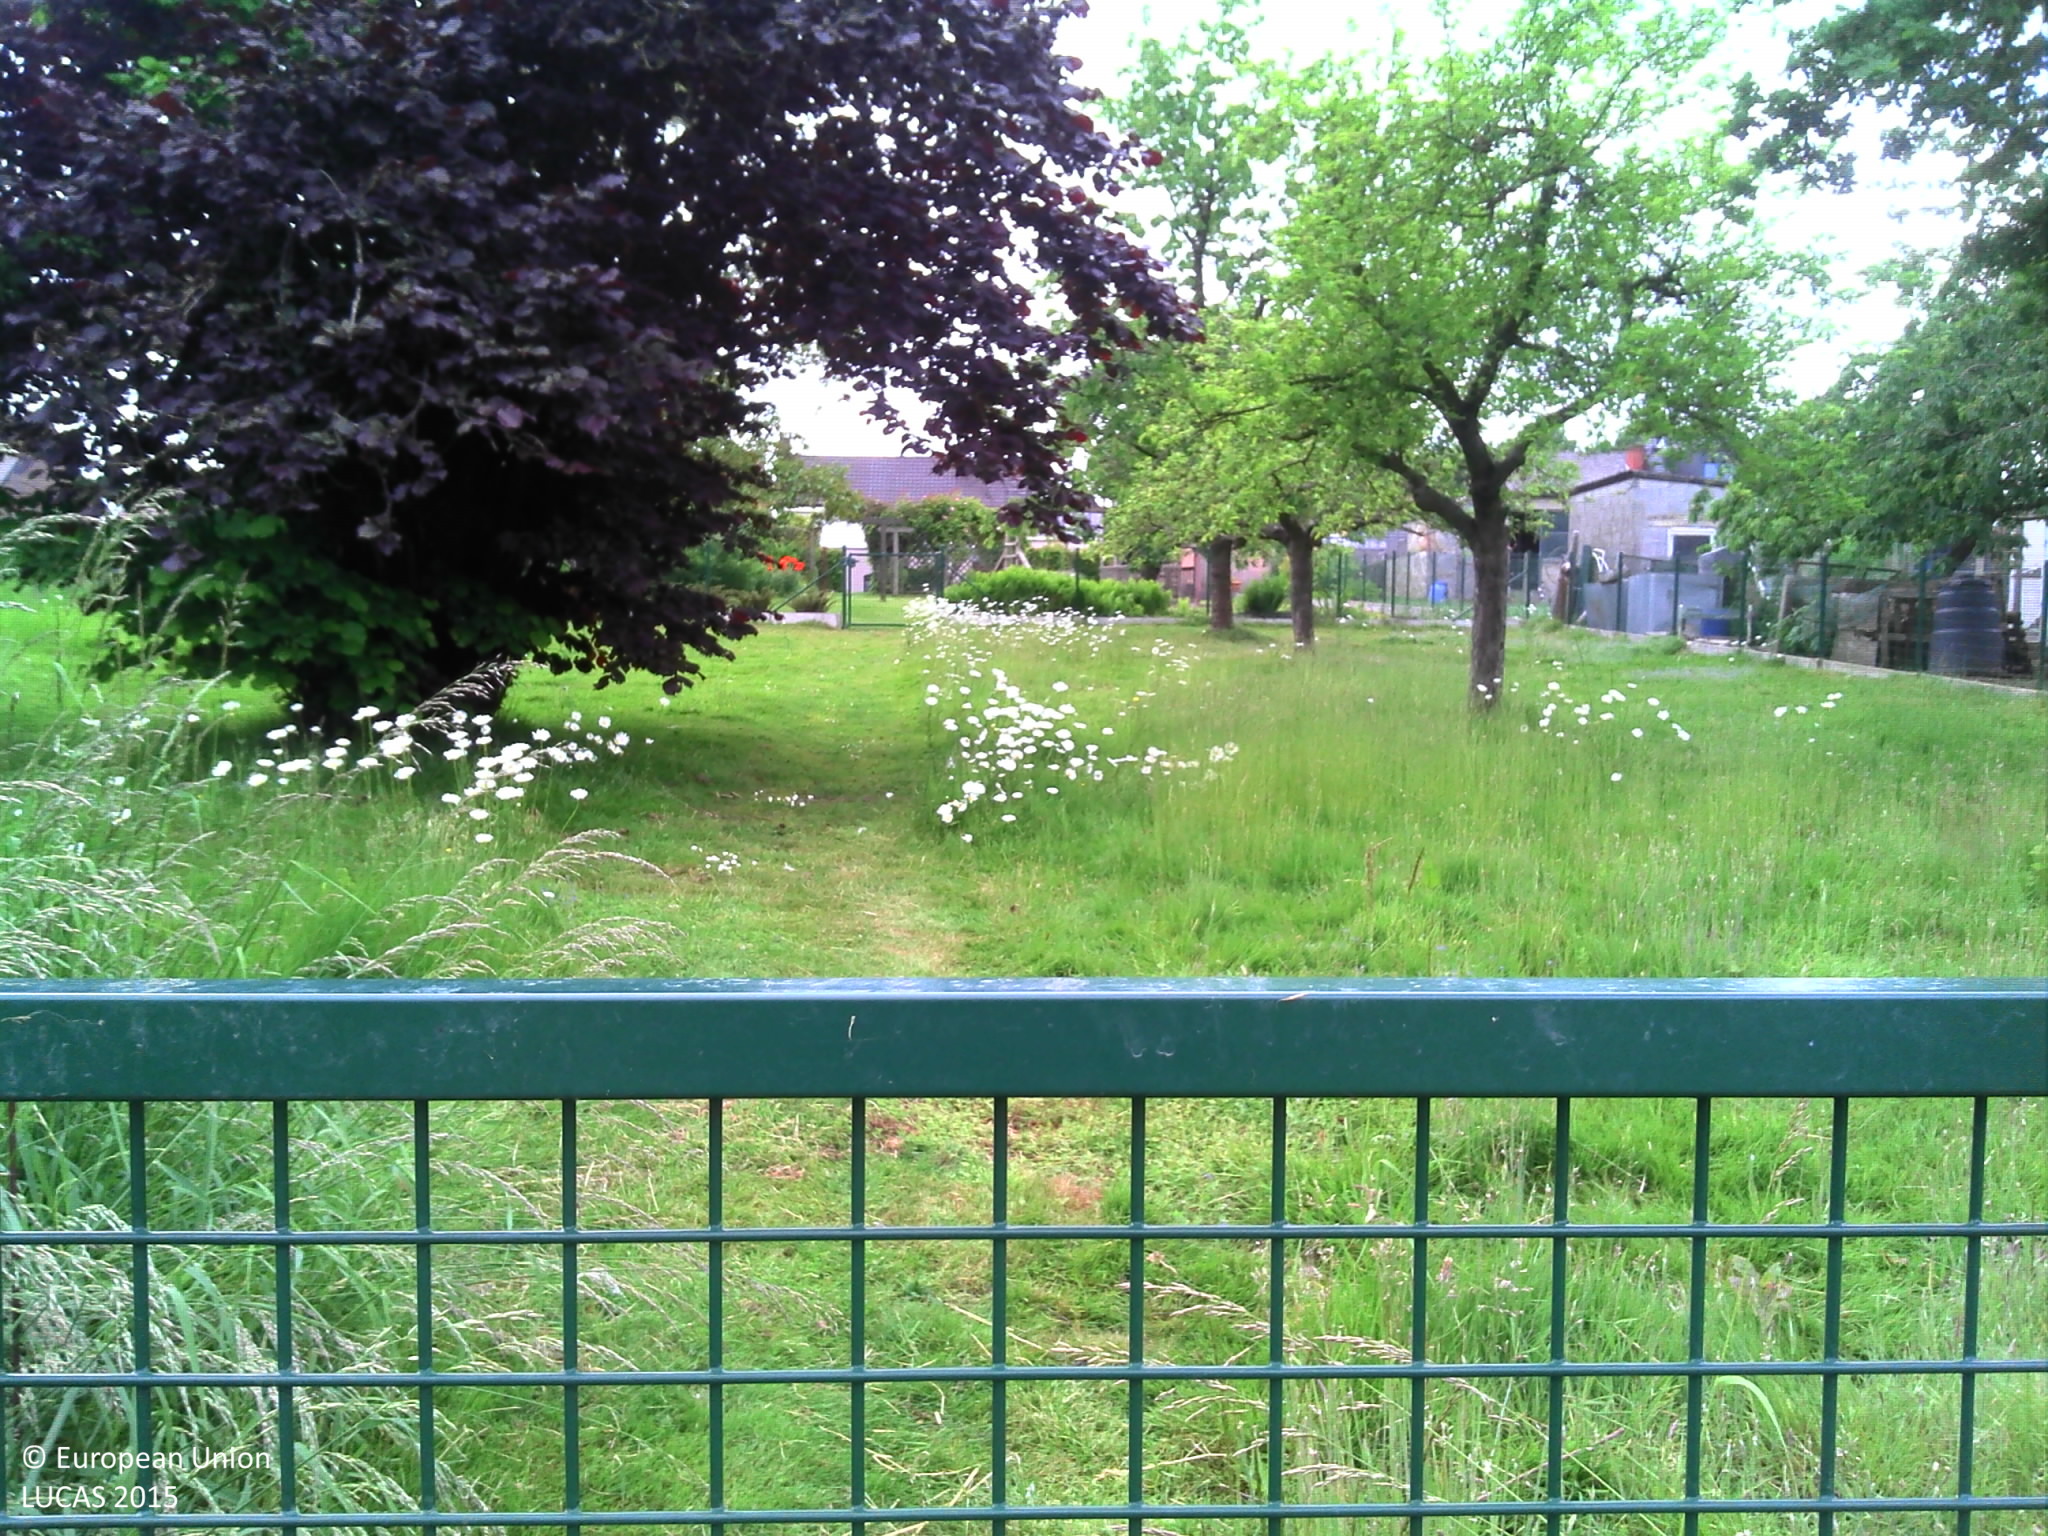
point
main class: Grassland
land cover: Grassland with sparse tree/shrub cover
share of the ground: > 75 %
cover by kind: herbaceous plants 95 %, broadleaved forest trees 5 %
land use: Residential
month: June
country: BE
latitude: 50.7594
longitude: 3.8837
